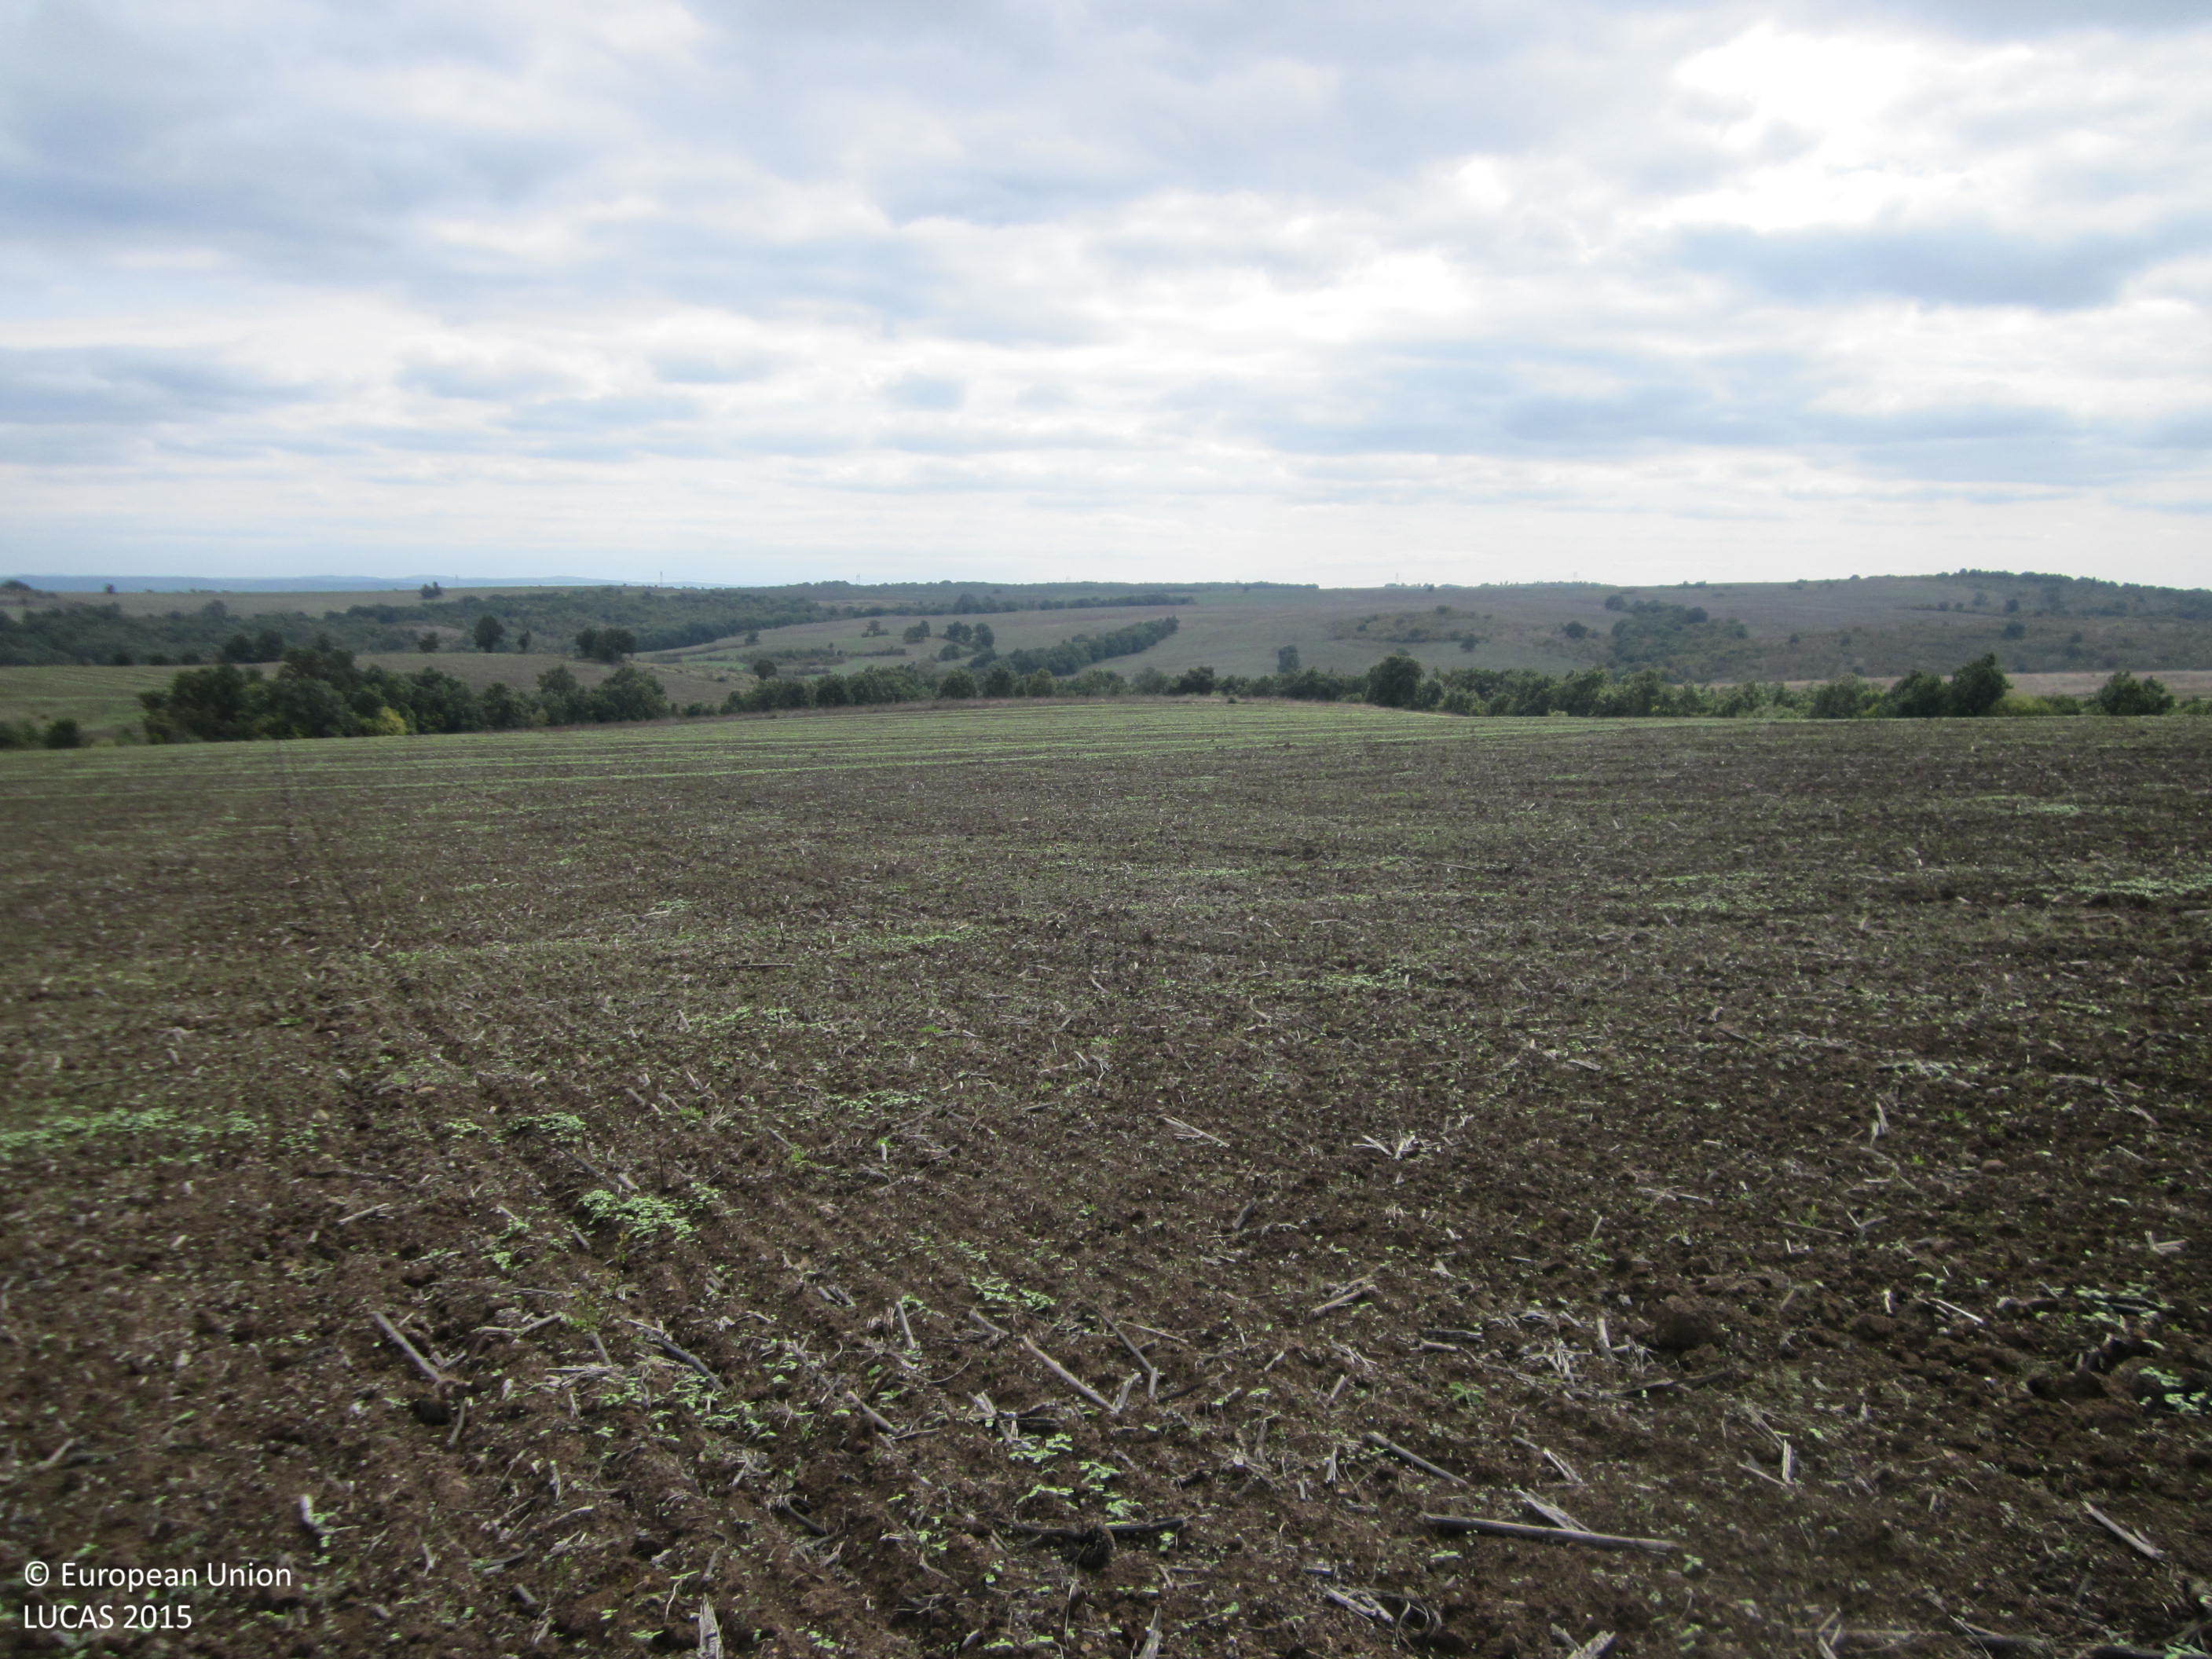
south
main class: Cropland
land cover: Sunflower
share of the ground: < 10 %
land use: Agriculture (excluding fallow land and kitchen gardens)
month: October
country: BG
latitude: 42.3658
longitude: 26.9930
